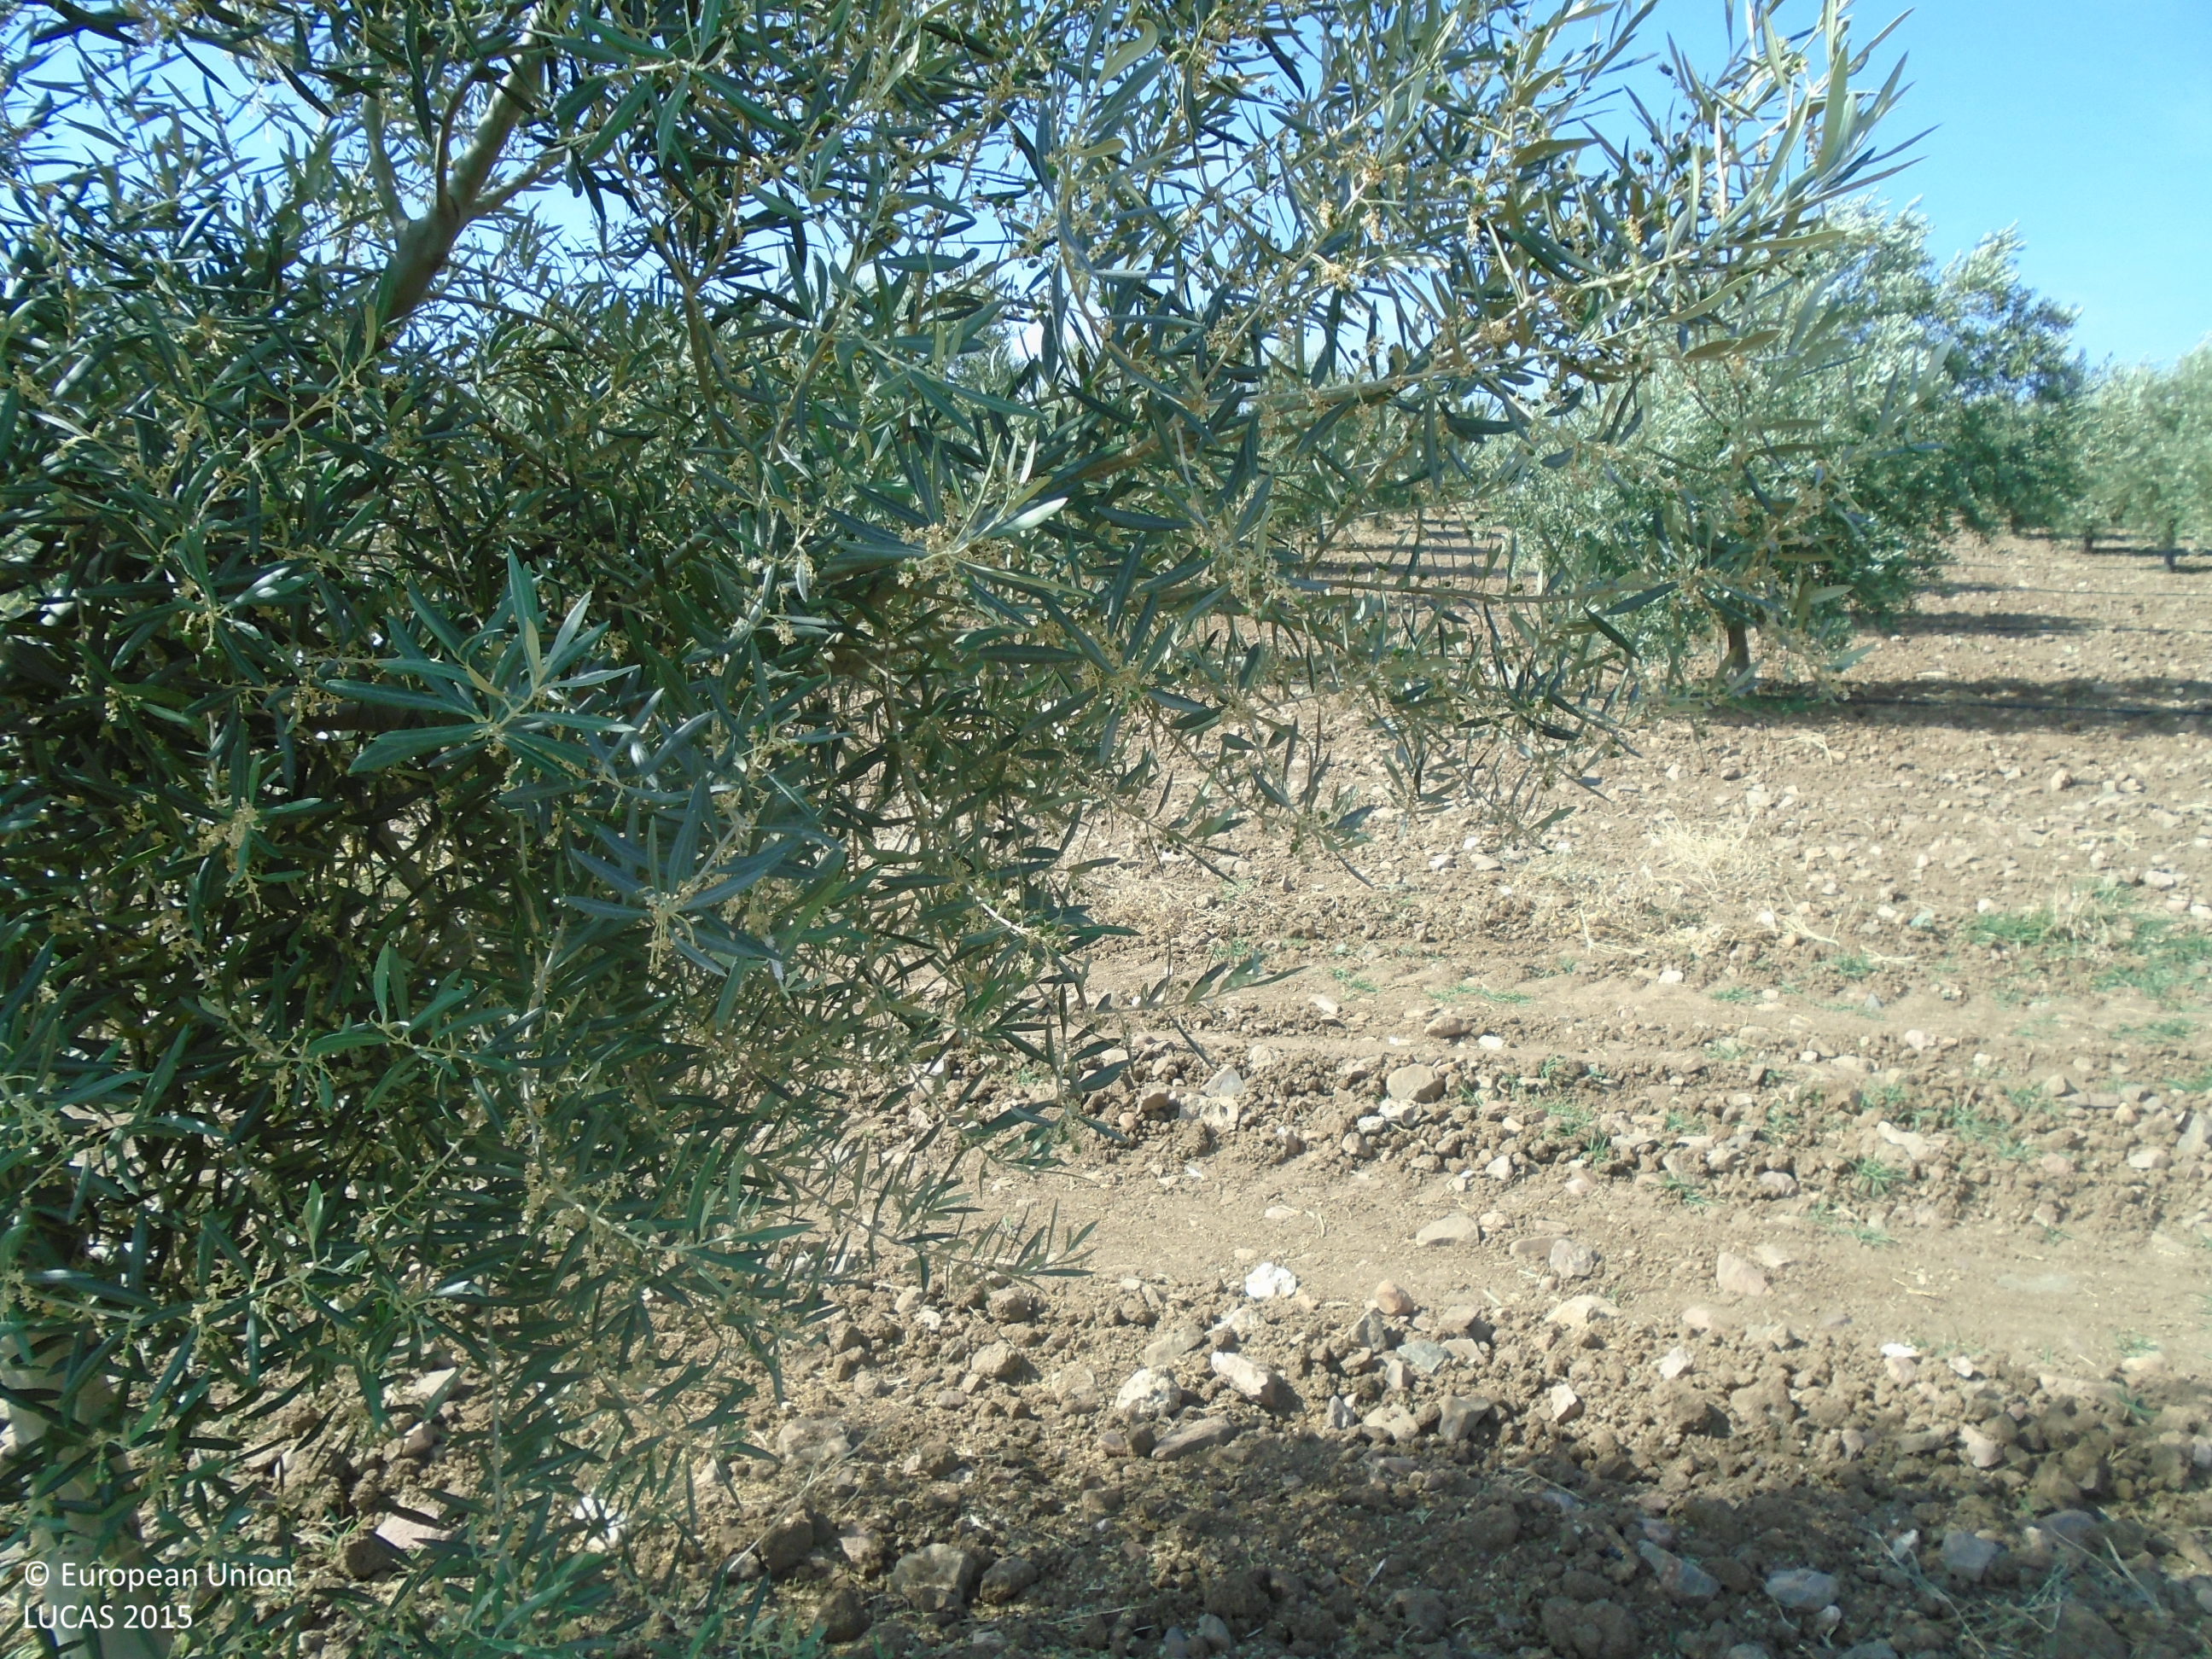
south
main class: Cropland
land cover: Olive groves
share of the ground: 10 - 25 %
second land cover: Other bare soil
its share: > 75 %
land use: Agriculture (excluding fallow land and kitchen gardens)
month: June
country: ES
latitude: 39.8178
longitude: -3.8043
